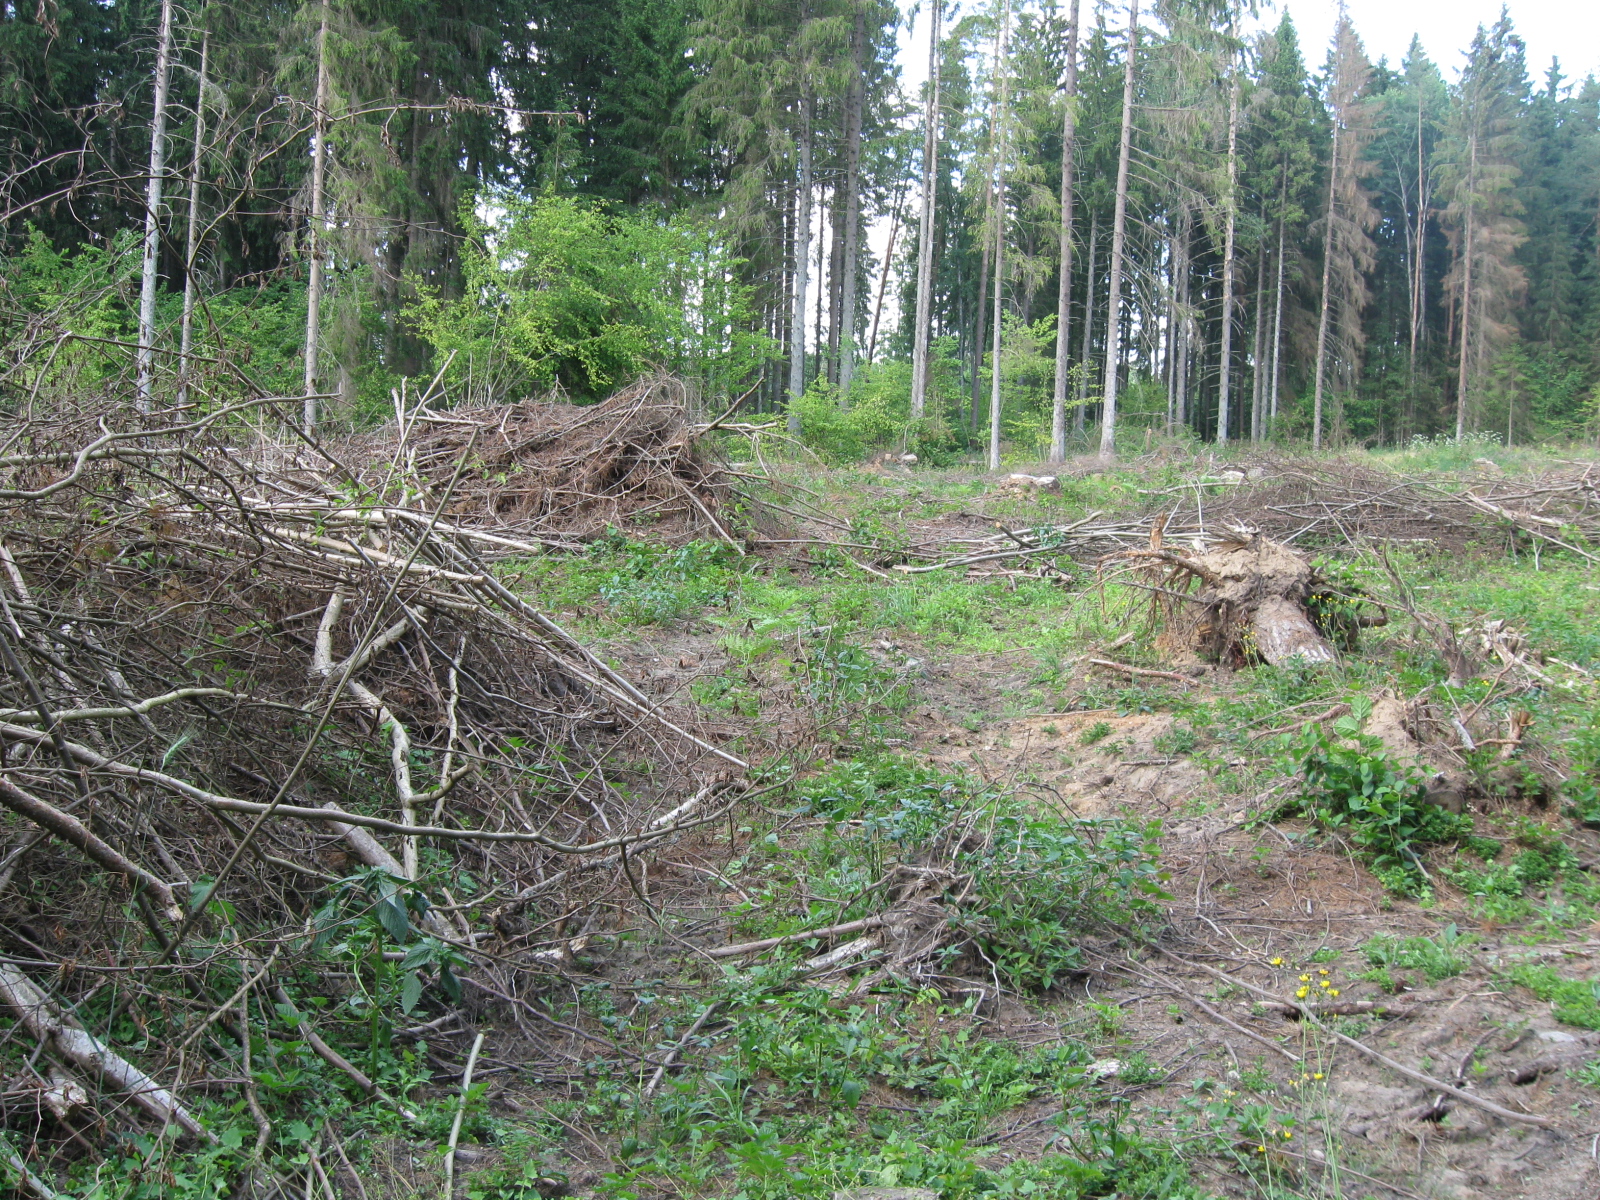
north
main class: Grassland
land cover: Spontaneously vegetated surfaces
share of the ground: > 75 %
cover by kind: herbaceous plants 75 %, unconsolidated bare surface 25 %
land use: Forestry
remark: Clear cut
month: July
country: LT
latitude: 54.2266
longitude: 24.3189
